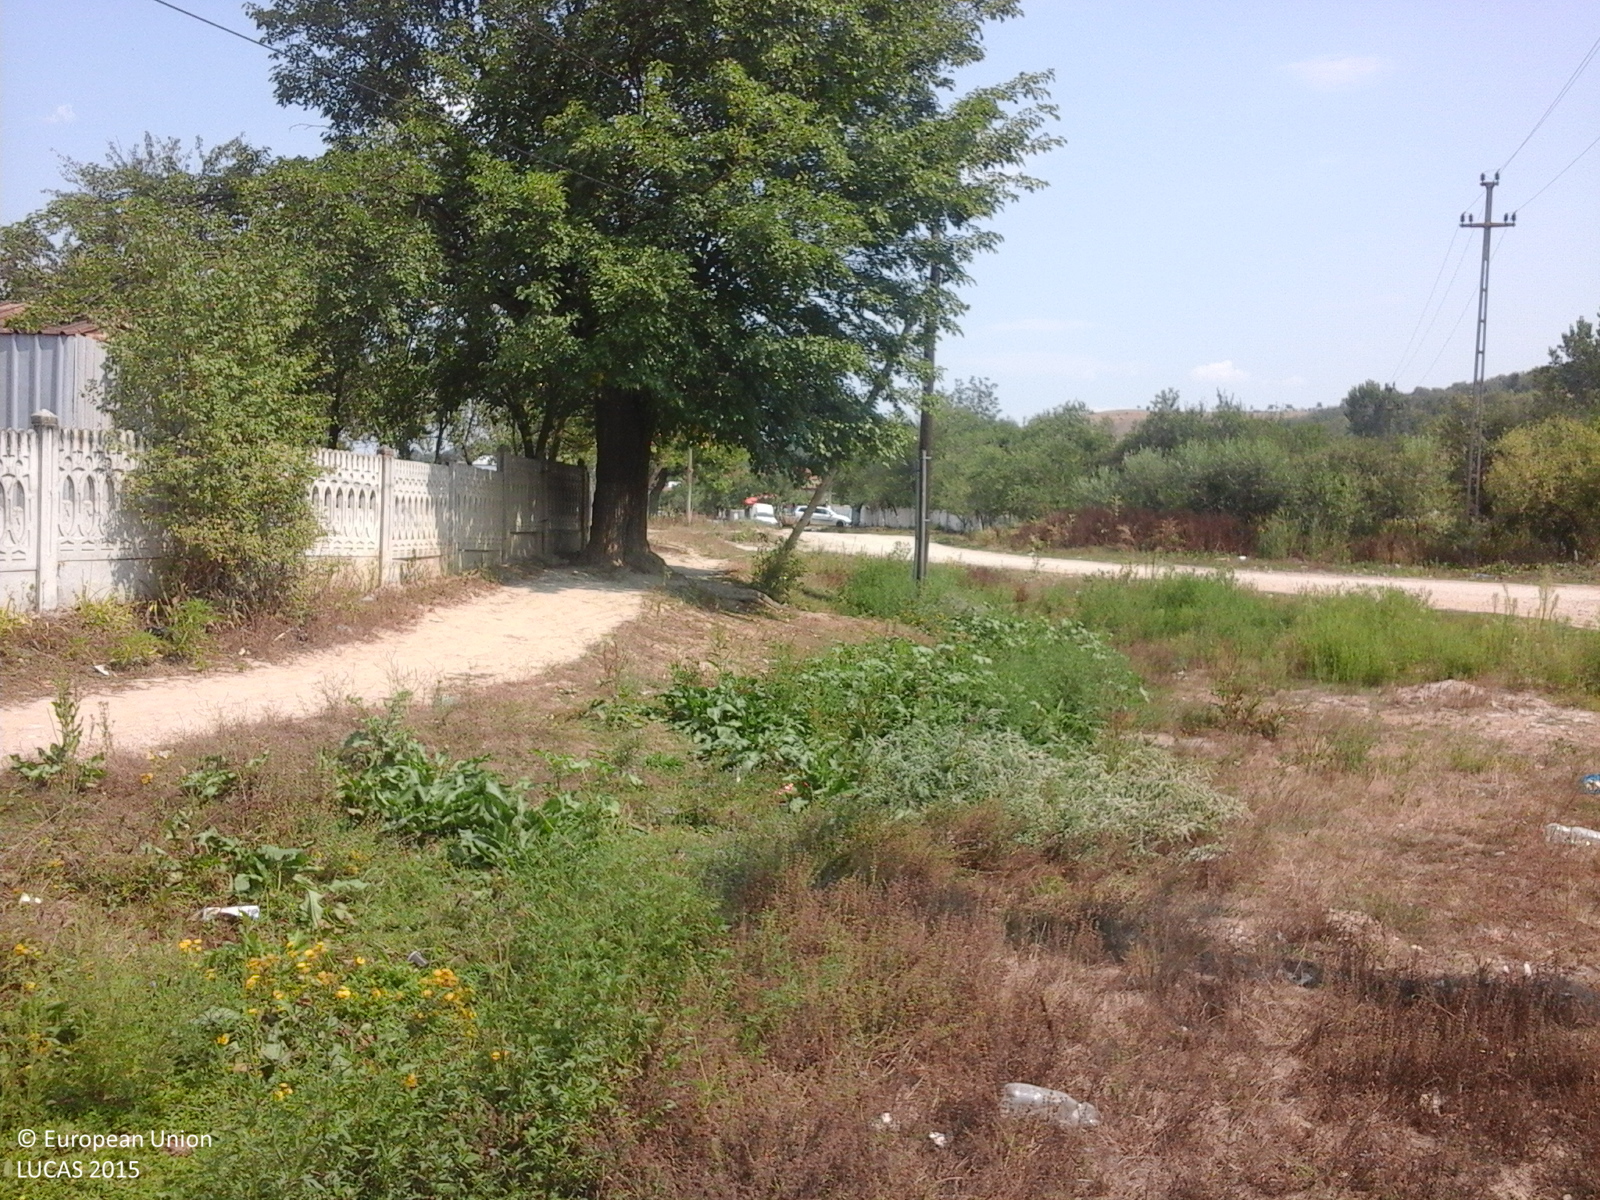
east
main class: Grassland
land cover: Spontaneously vegetated surfaces
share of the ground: > 75 %
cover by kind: herbaceous plants 100 %
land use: Residential
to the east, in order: Spontaneously vegetated surfaces; Artificial constructions in urban areas
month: August
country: RO
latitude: 44.5869
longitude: 23.5704
